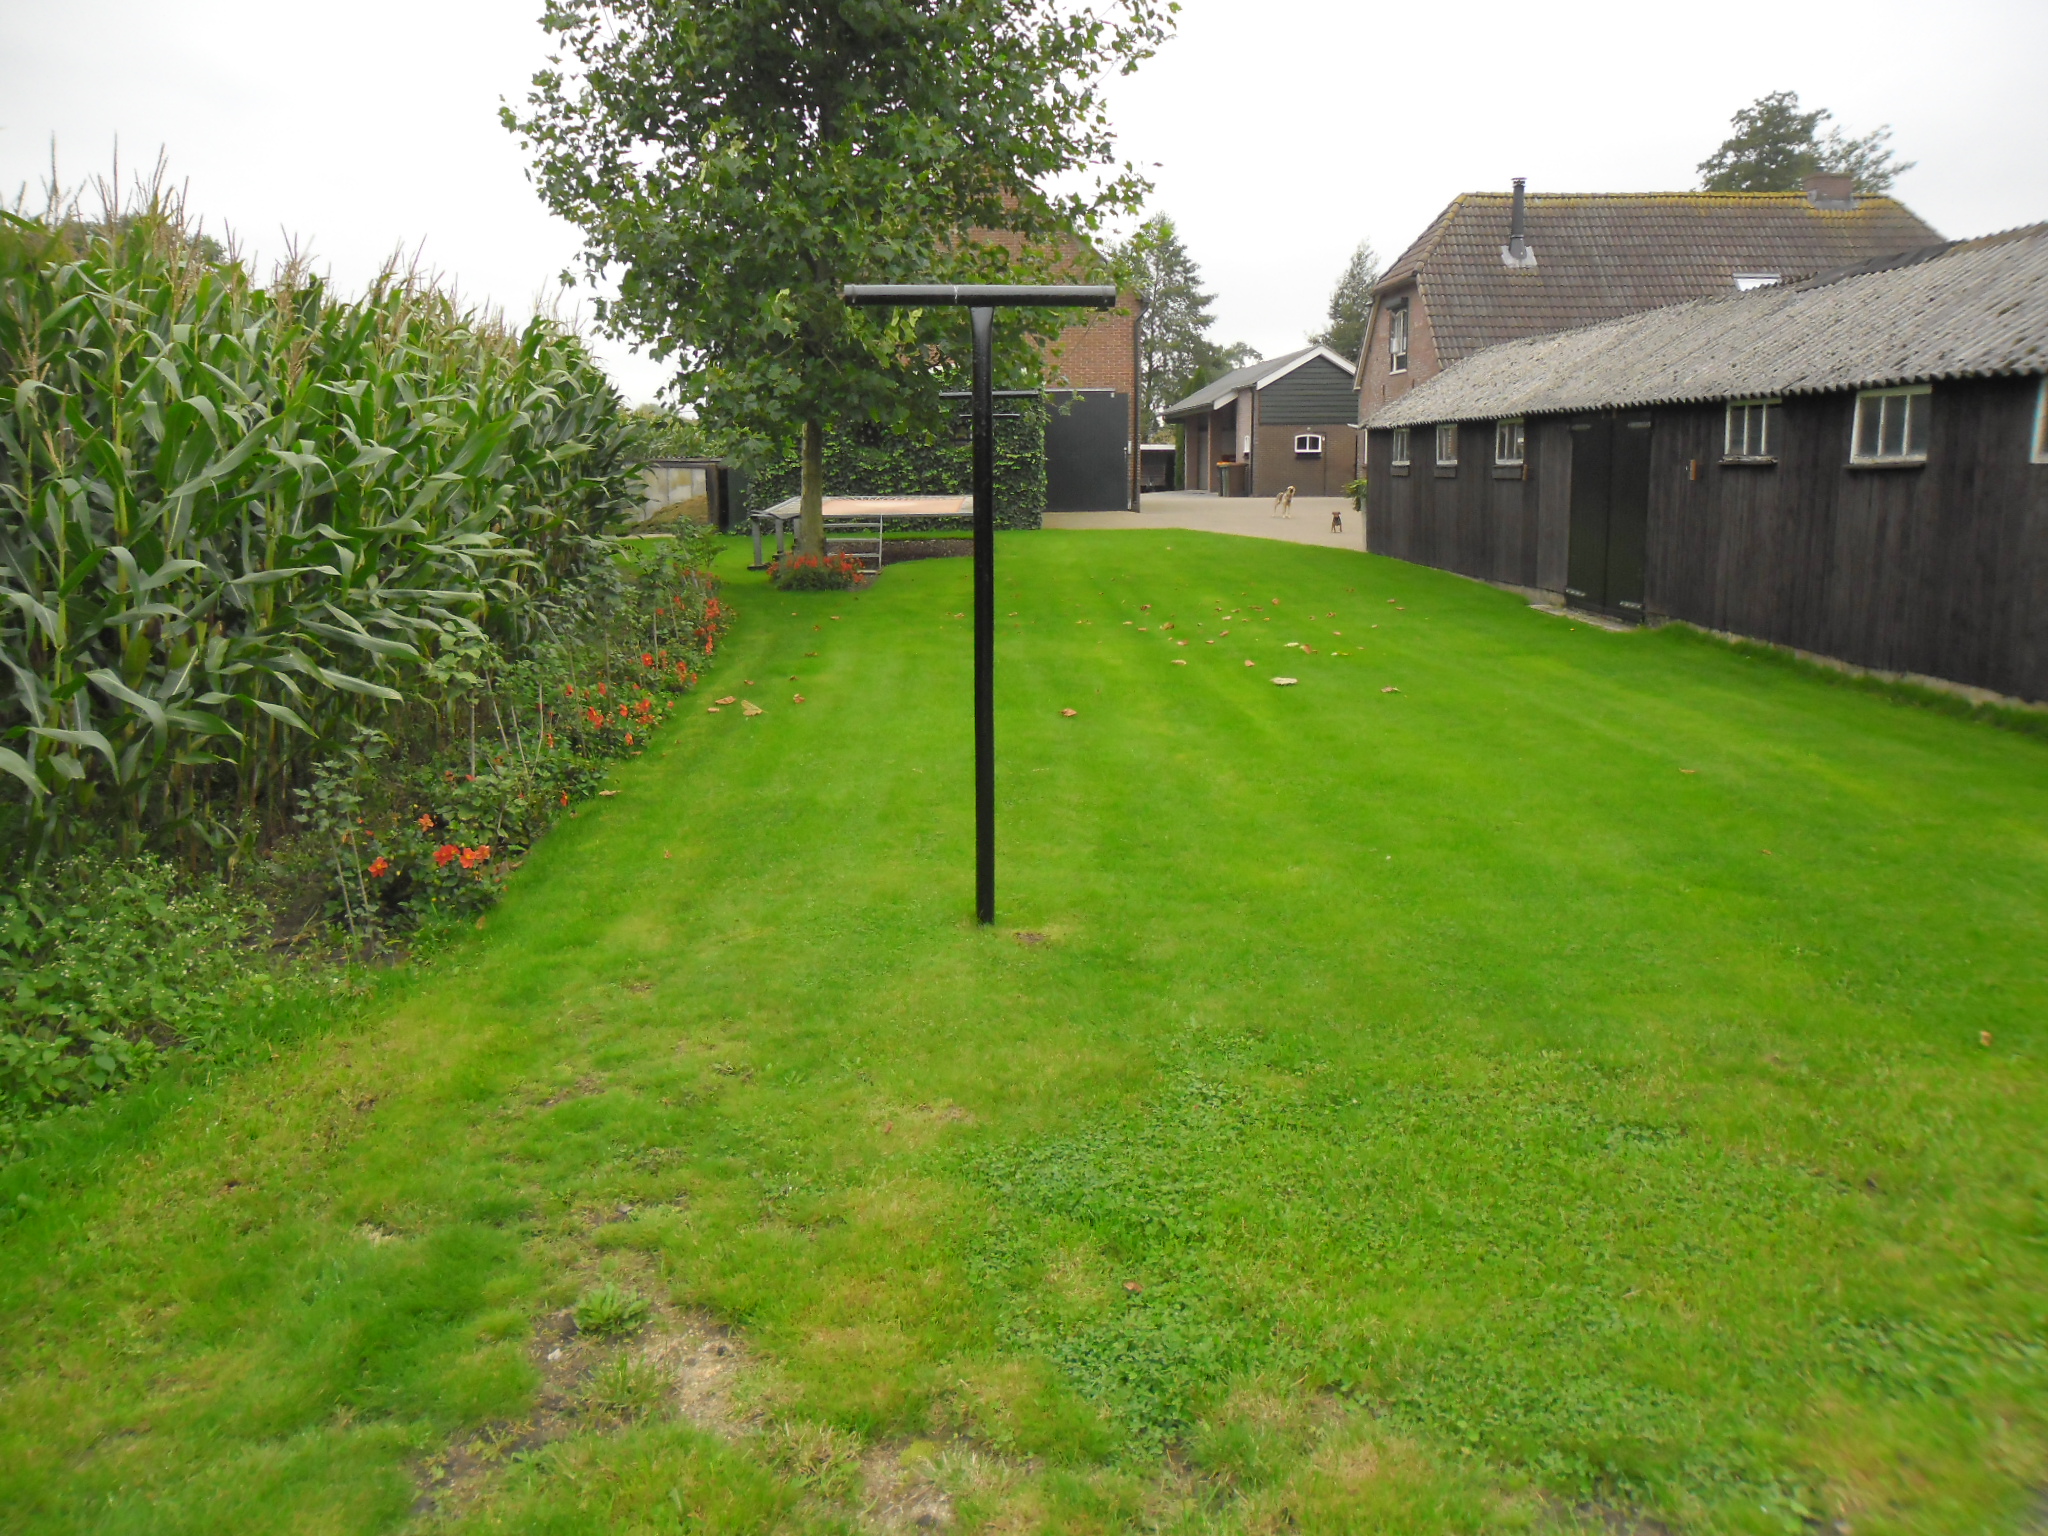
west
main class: Grassland
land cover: Grassland without tree/shrub cover
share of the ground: > 75 %
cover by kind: herbaceous plants 100 %
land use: Residential
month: September
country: NL
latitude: 52.1193
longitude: 5.6902
